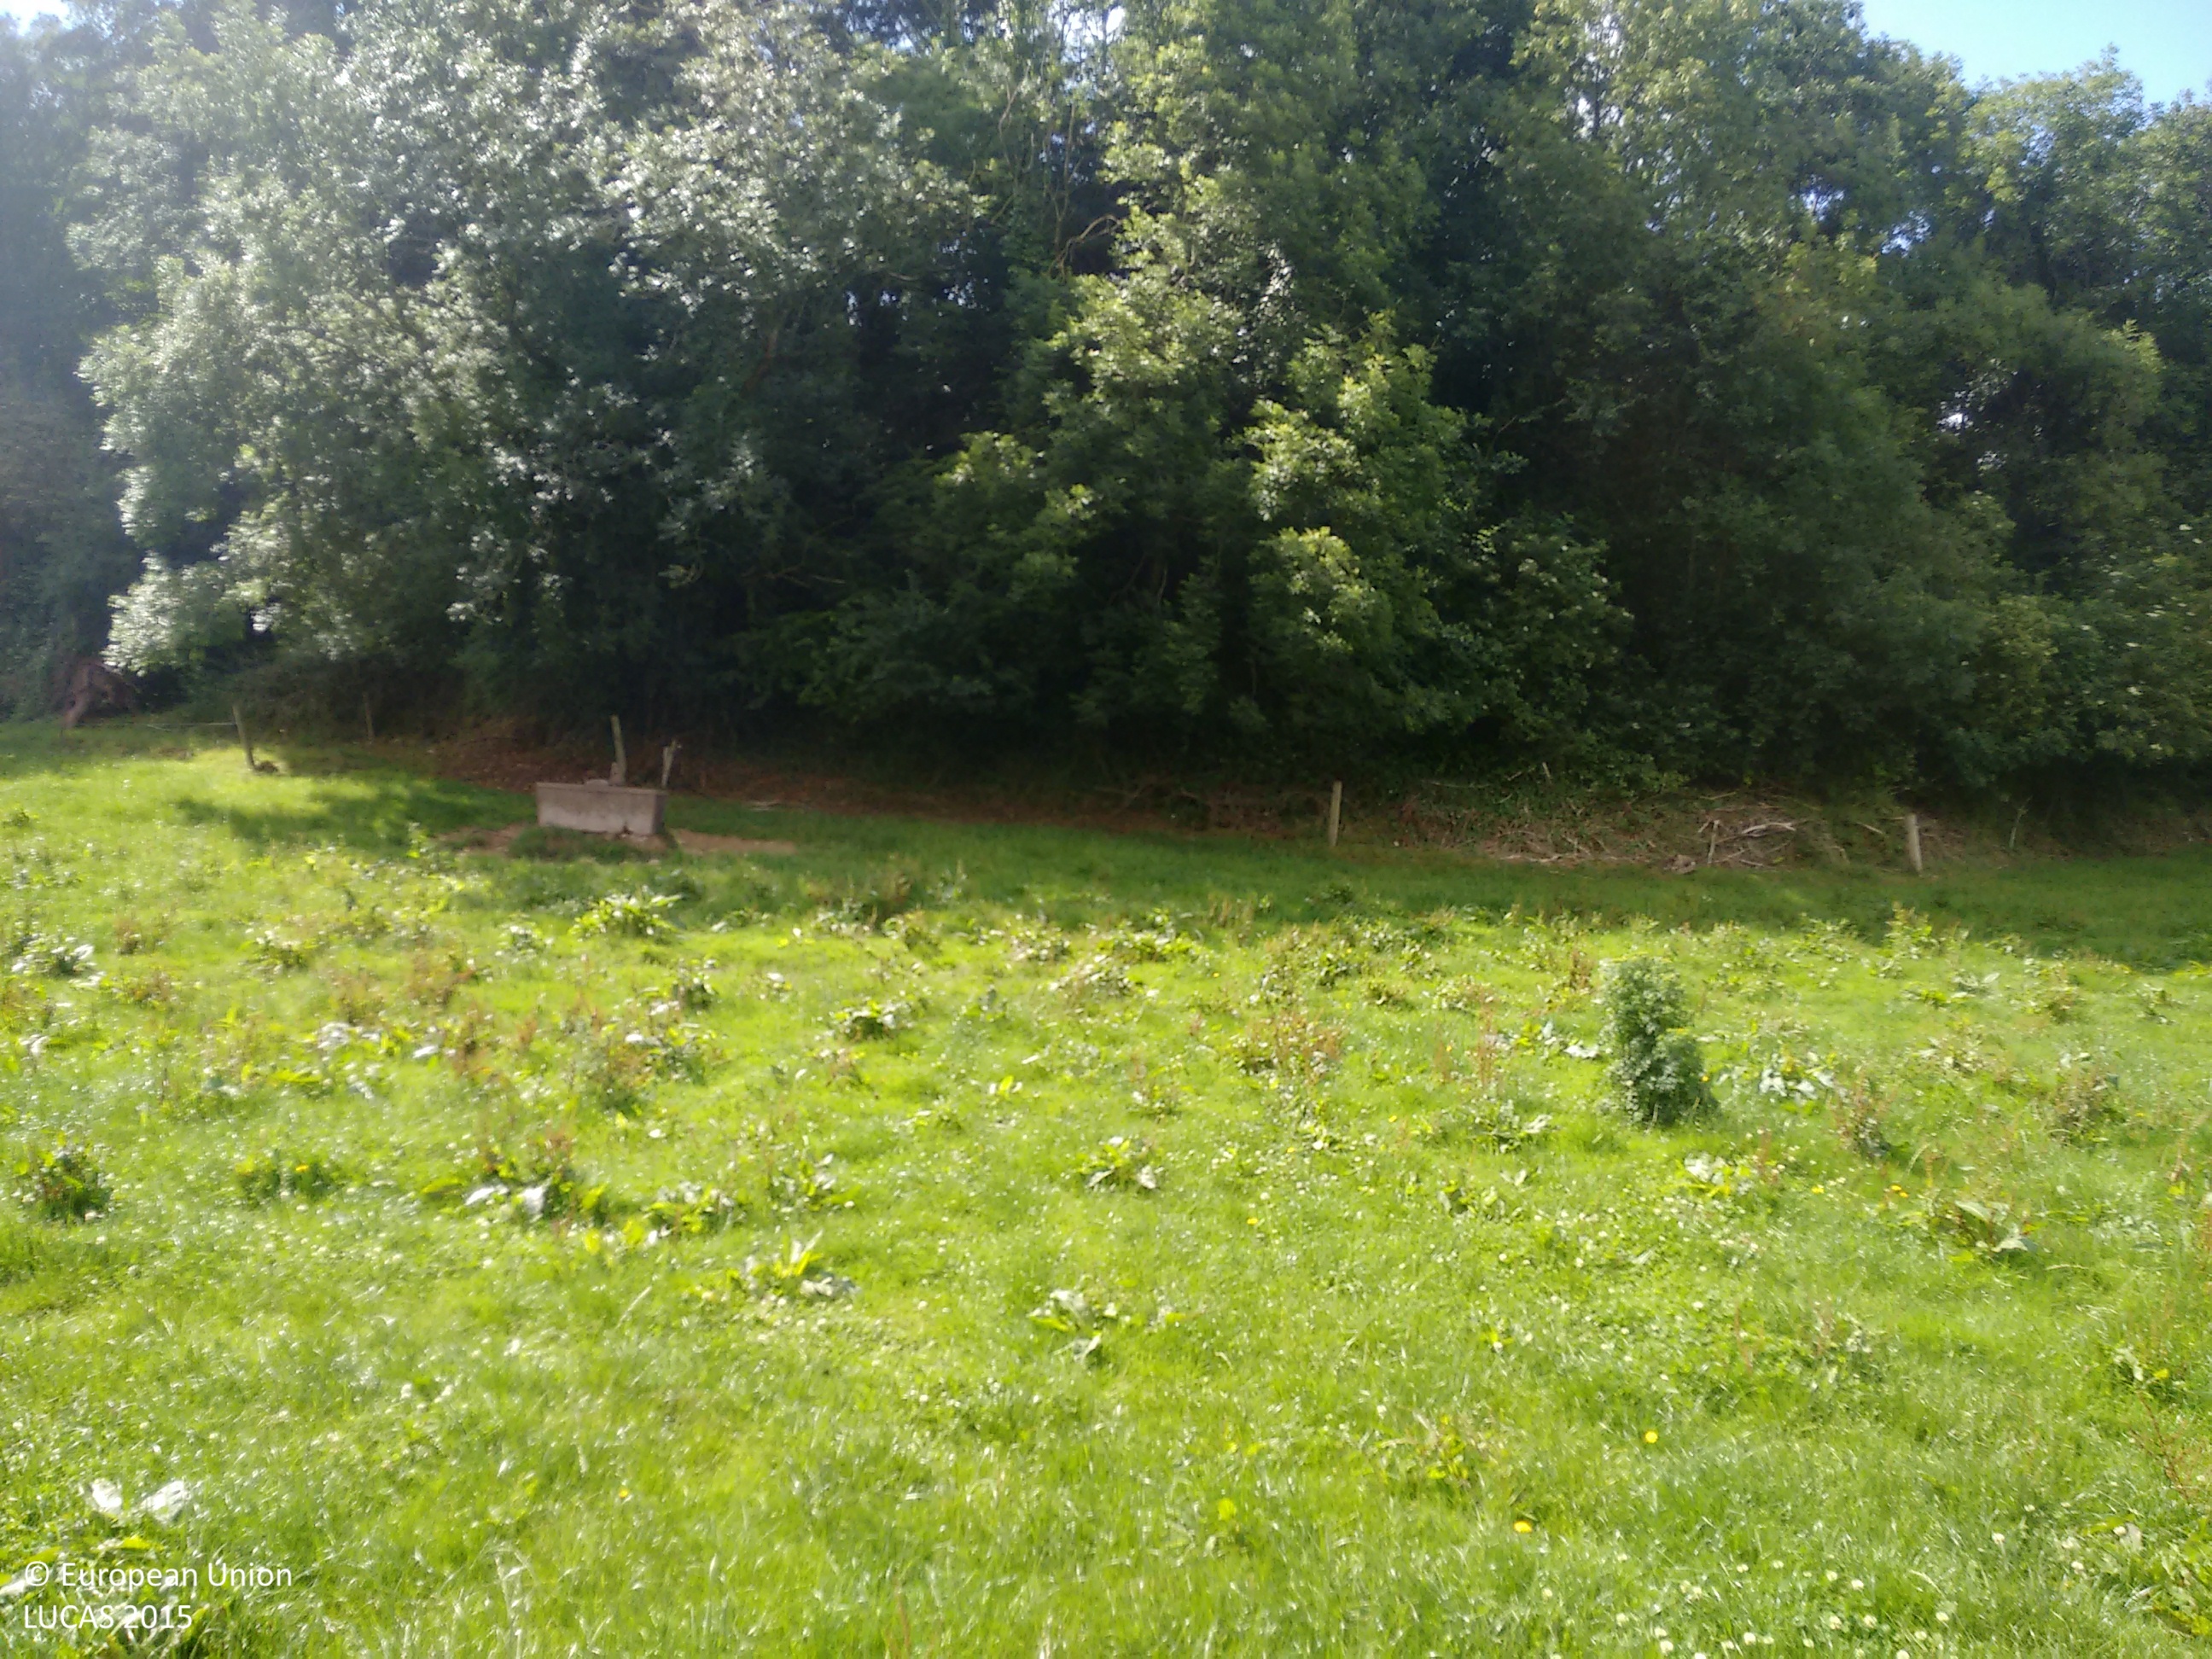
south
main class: Grassland
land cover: Grassland without tree/shrub cover
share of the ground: > 75 %
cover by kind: herbaceous plants 100 %
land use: Agriculture (excluding fallow land and kitchen gardens)
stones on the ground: < 10 %
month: July
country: IE
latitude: 52.1506
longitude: -8.4462
